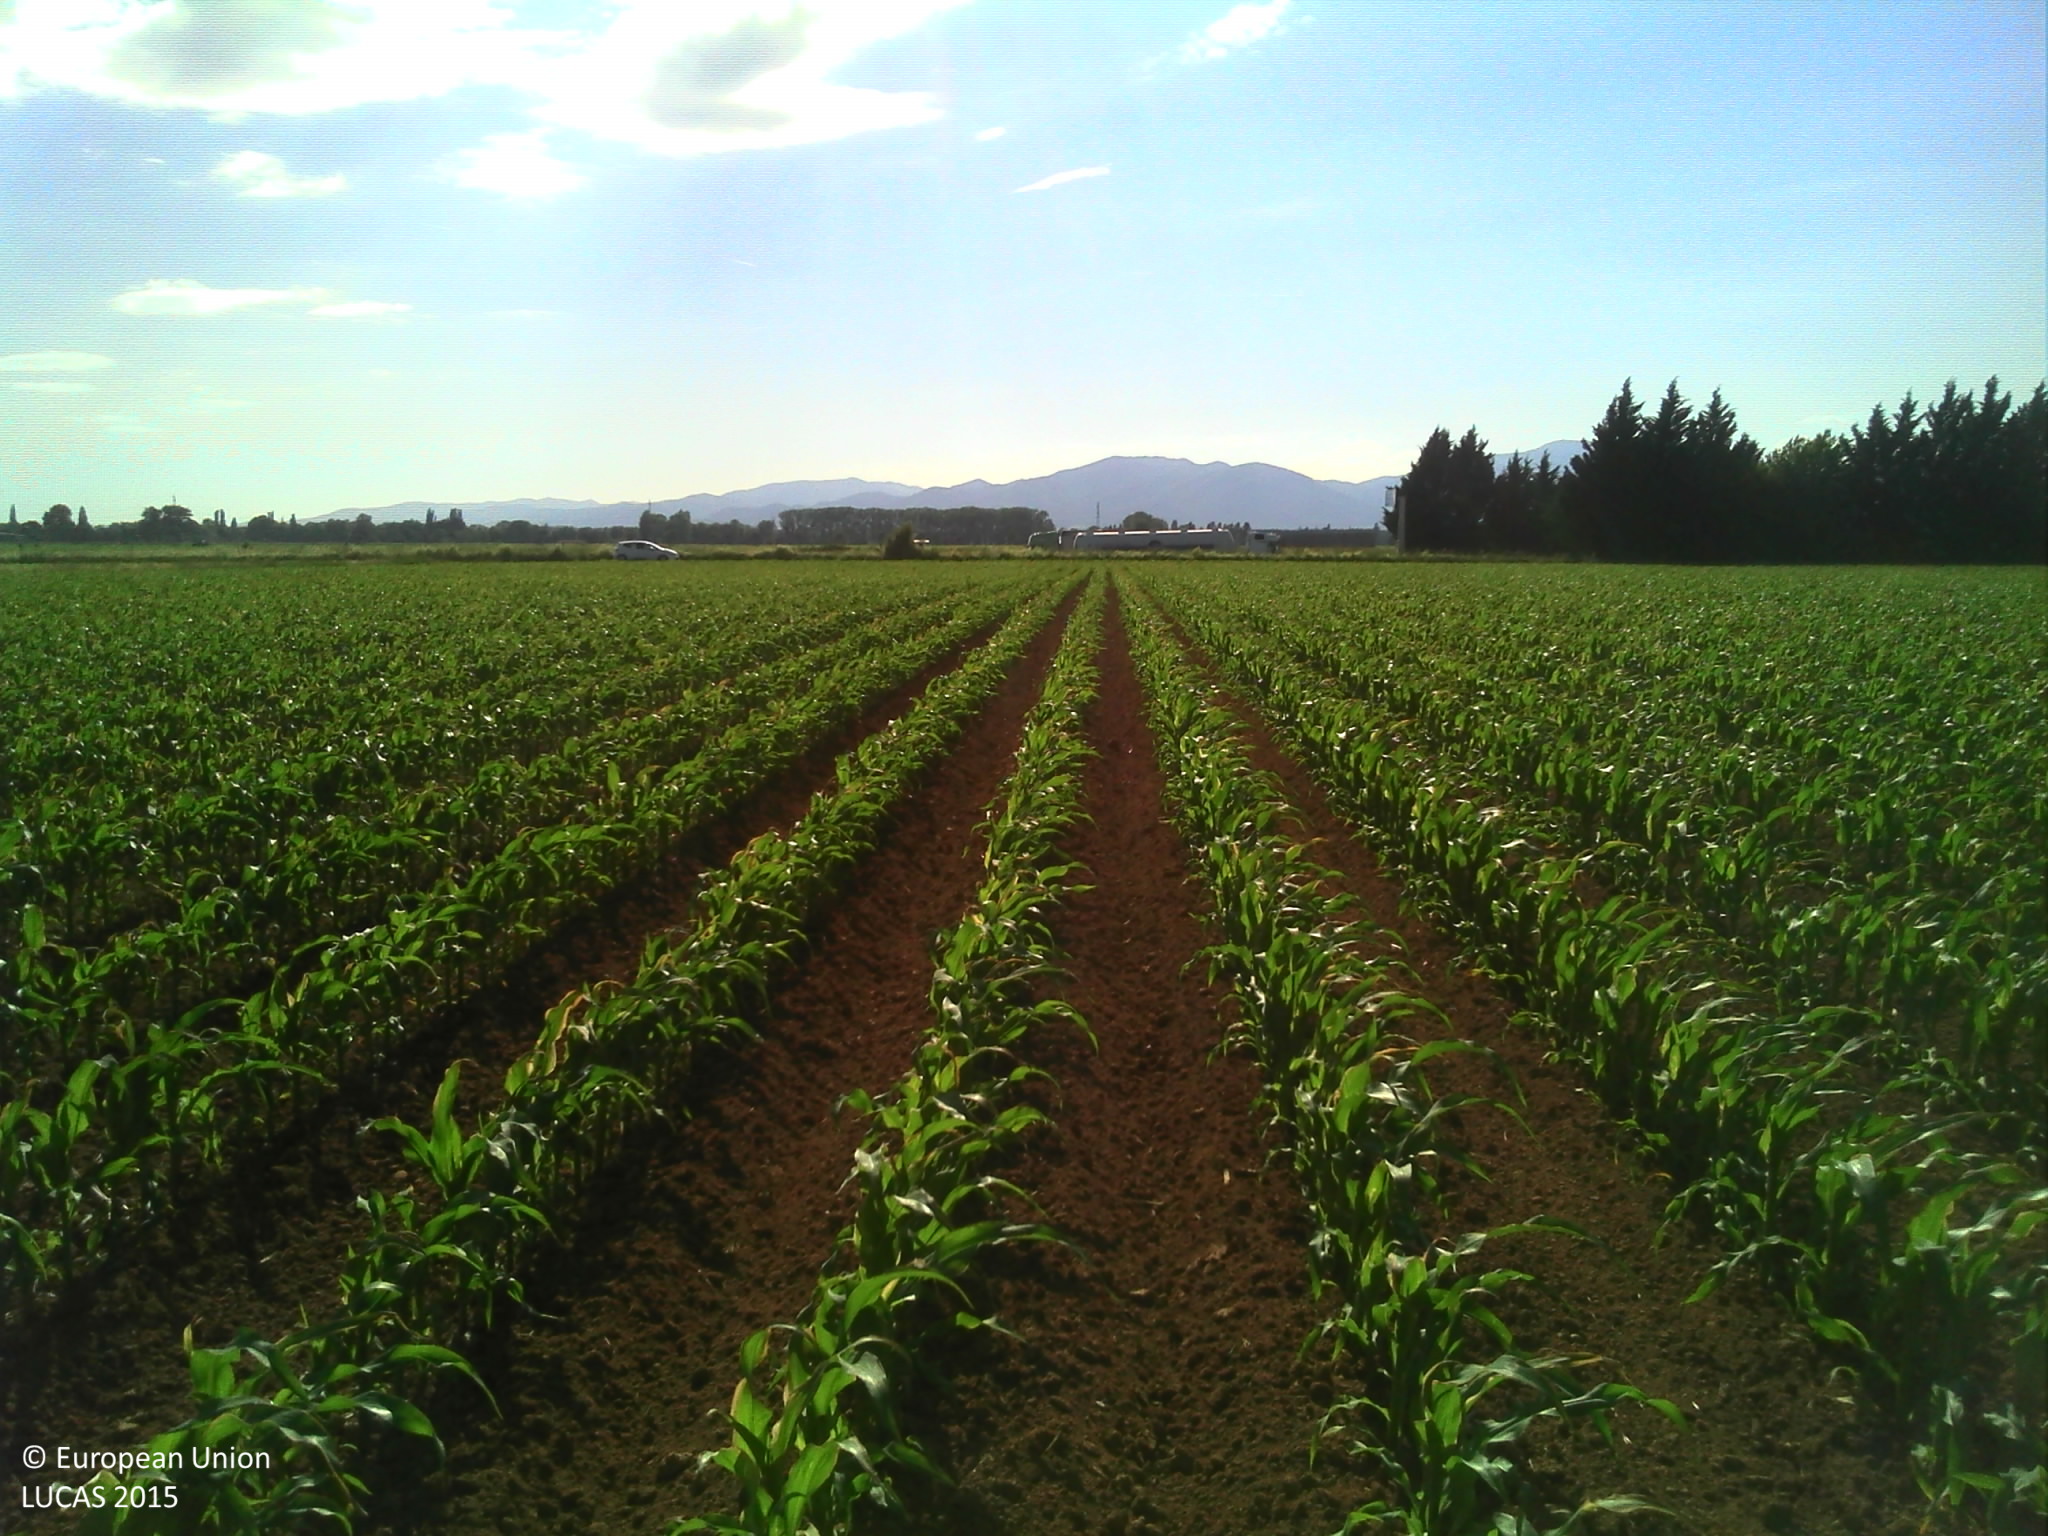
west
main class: Cropland
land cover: Maize
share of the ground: 50 - 75 %
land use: Agriculture (excluding fallow land and kitchen gardens)
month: June
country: FR
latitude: 47.8327
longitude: 7.3963
